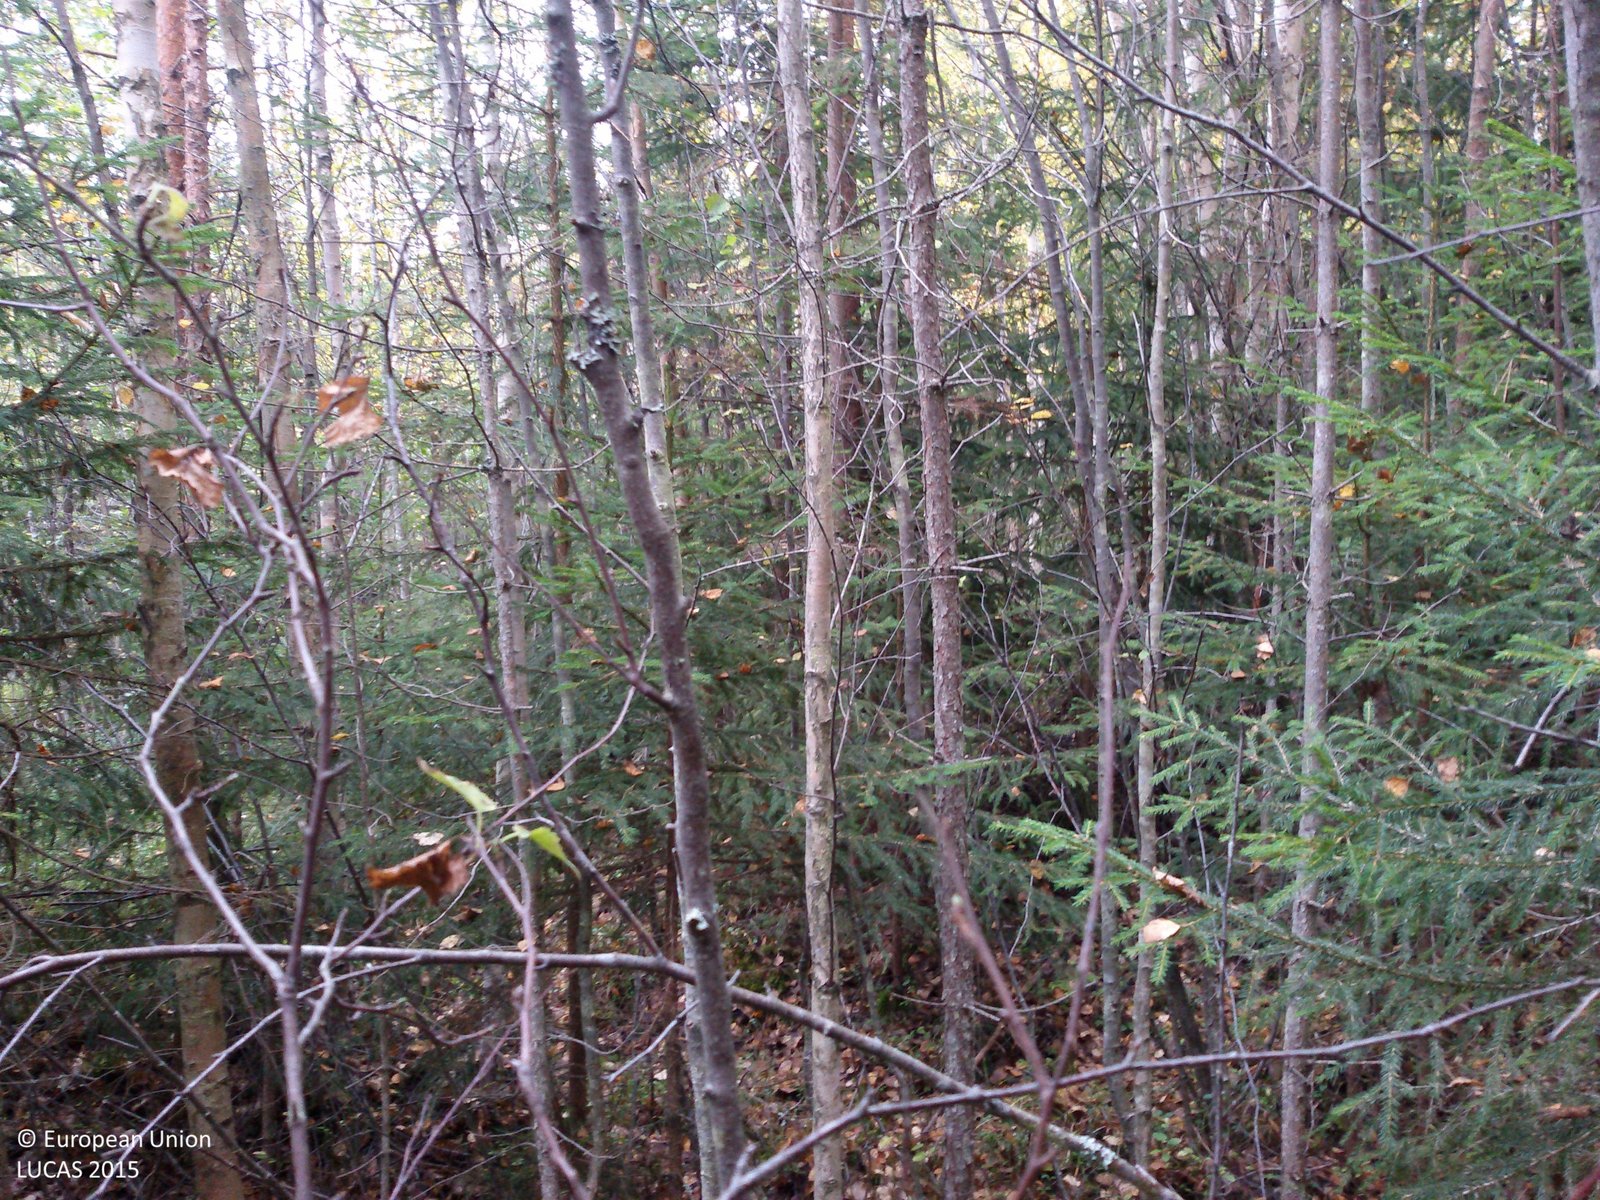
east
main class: Woodland
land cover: Spruce dominated mixed woodland
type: boreal forest
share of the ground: > 75 %
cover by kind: coniferous forest trees 50 %, broadleaved forest trees 50 %
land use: Forestry
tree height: > 5 m
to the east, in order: Spruce dominated mixed woodland; Broadleaved woodland; Pine dominated mixed woodland; Rivers and streams; Pine dominated mixed woodland
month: September
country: SE
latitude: 60.7469
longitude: 14.8485
